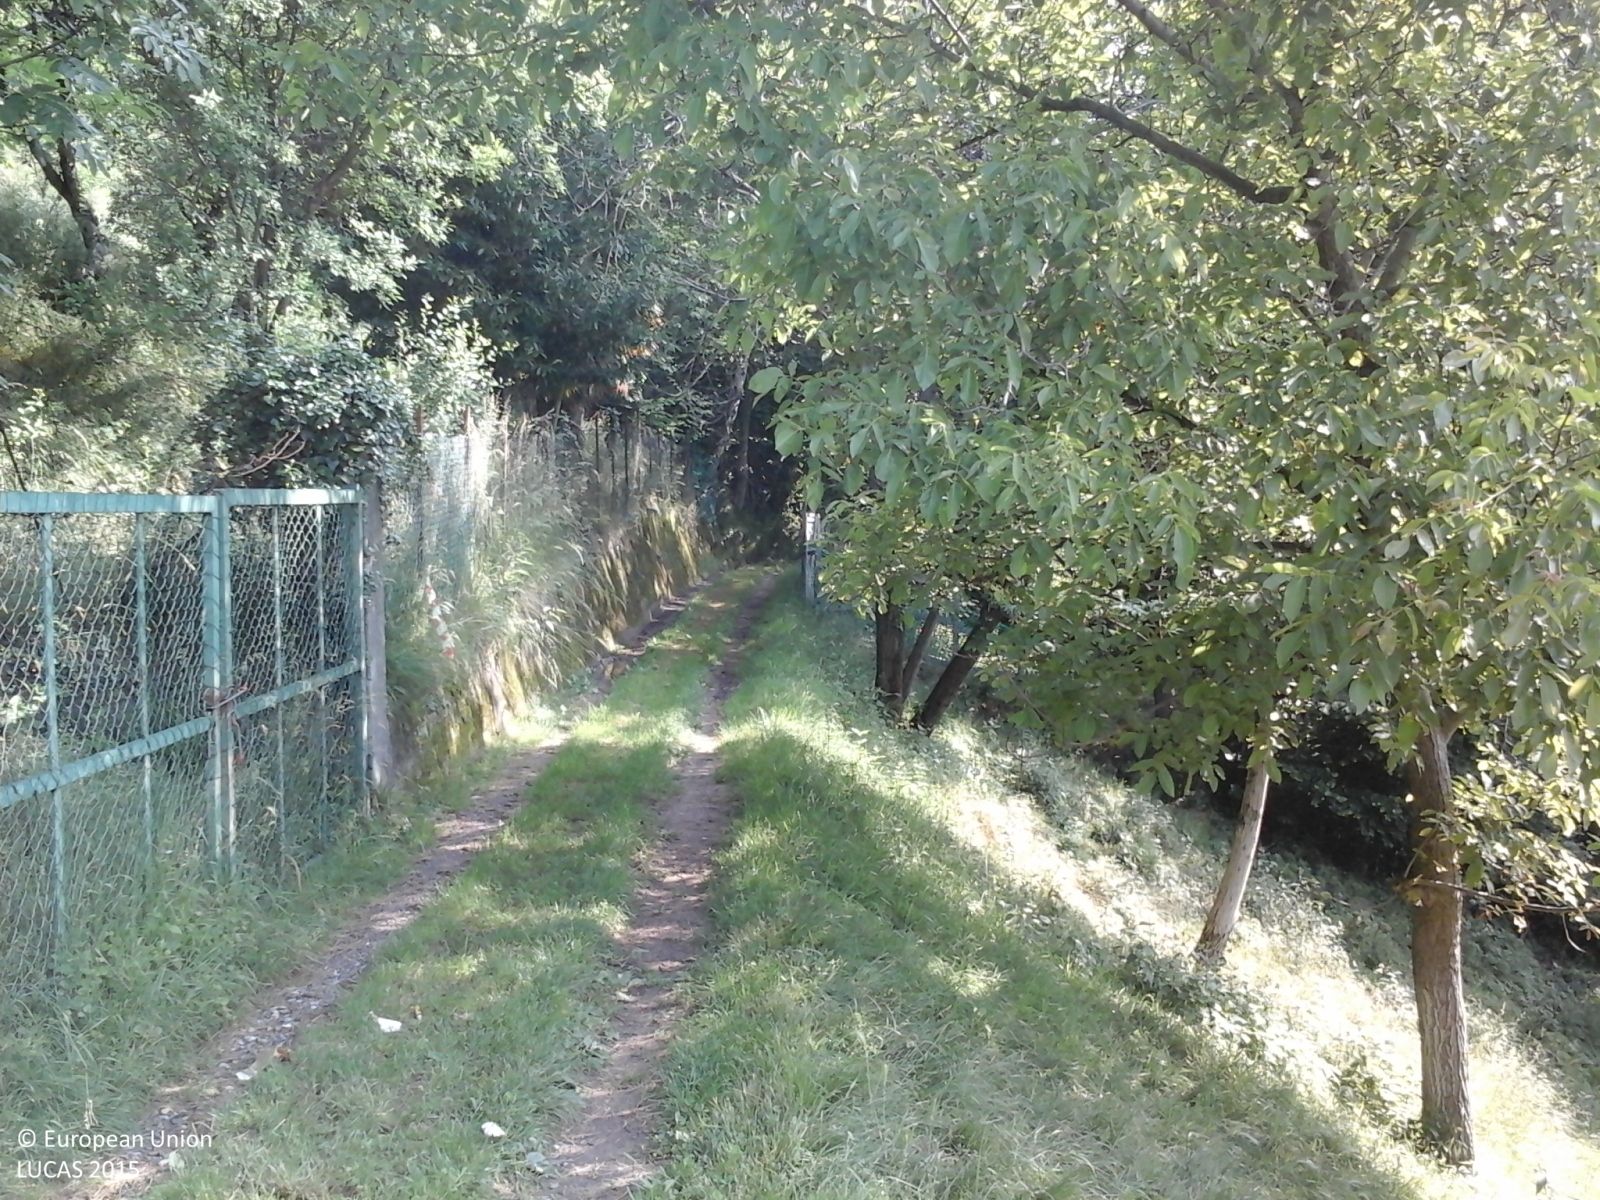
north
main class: Woodland
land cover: Broadleaved woodland
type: thermophilous deciduous forest
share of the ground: > 75 %
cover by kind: broadleaved forest trees 100 %
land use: Forestry
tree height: > 5 m
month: May
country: IT
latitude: 45.5954
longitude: 8.0929
